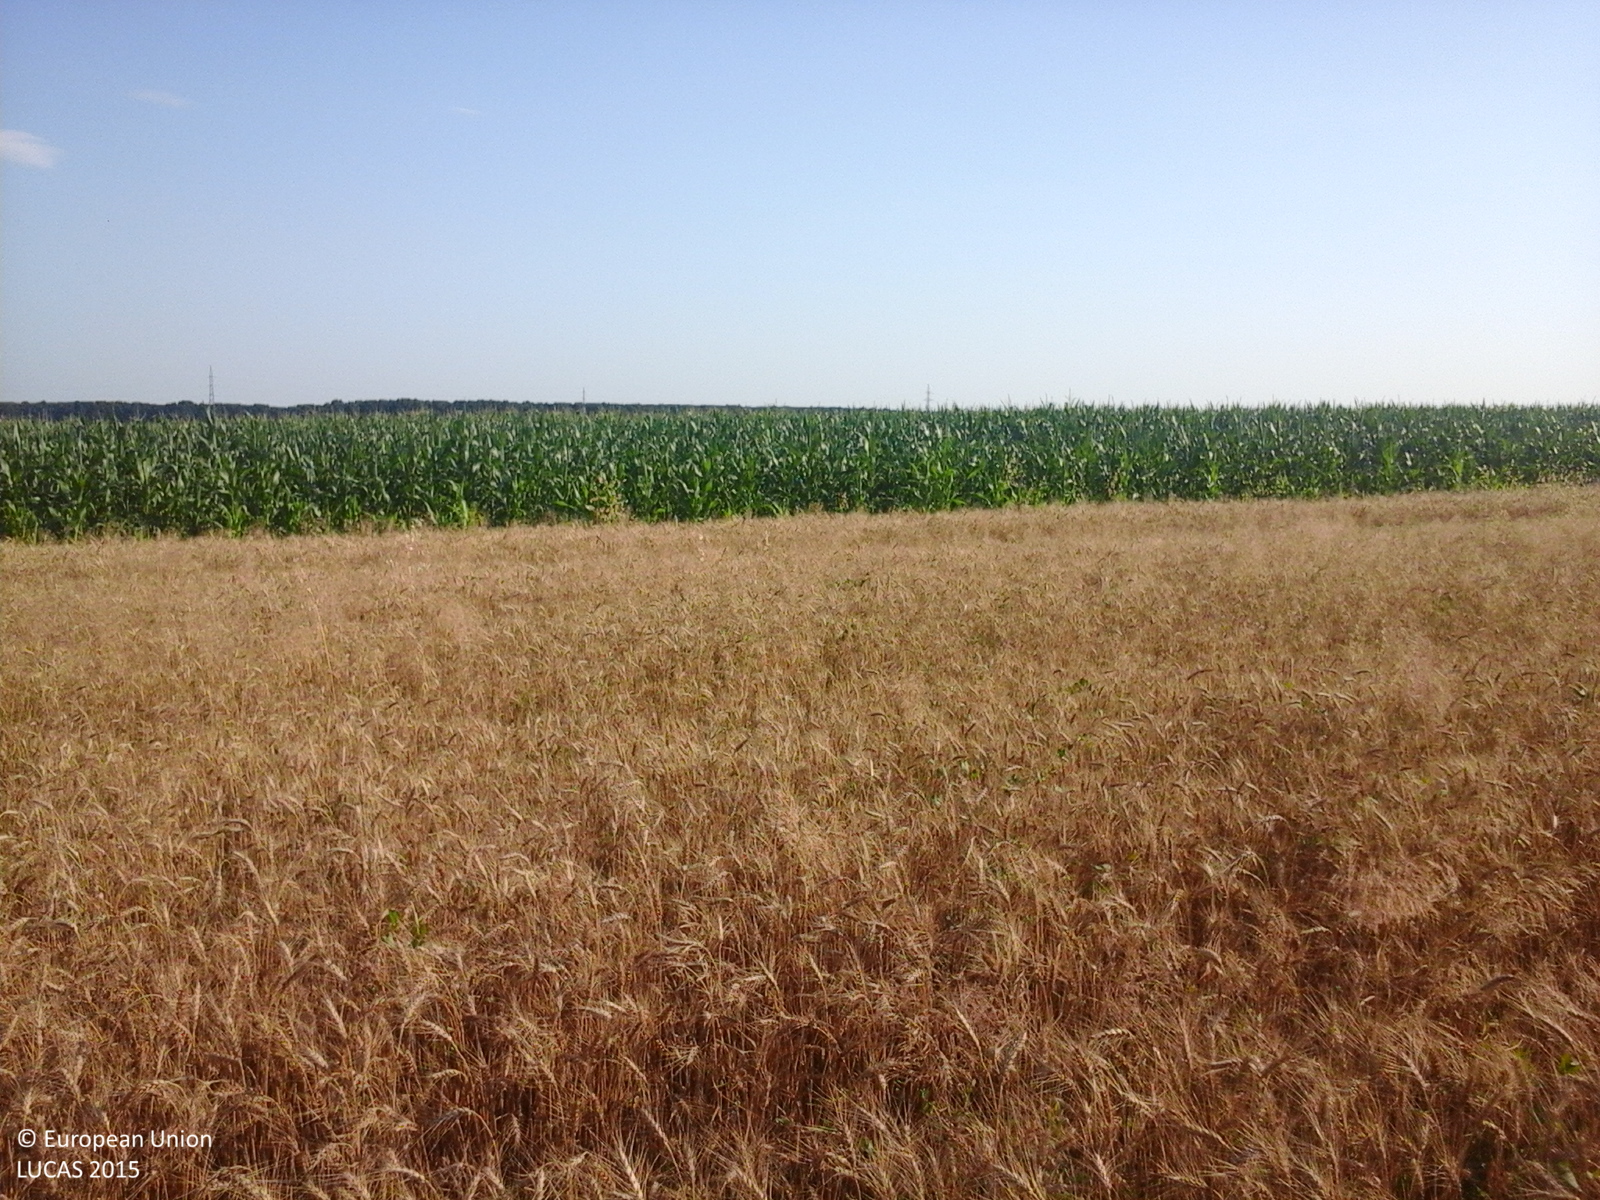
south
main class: Cropland
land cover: Common wheat
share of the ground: > 75 %
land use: Agriculture (excluding fallow land and kitchen gardens)
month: July
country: RO
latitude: 44.5788
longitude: 24.5687
